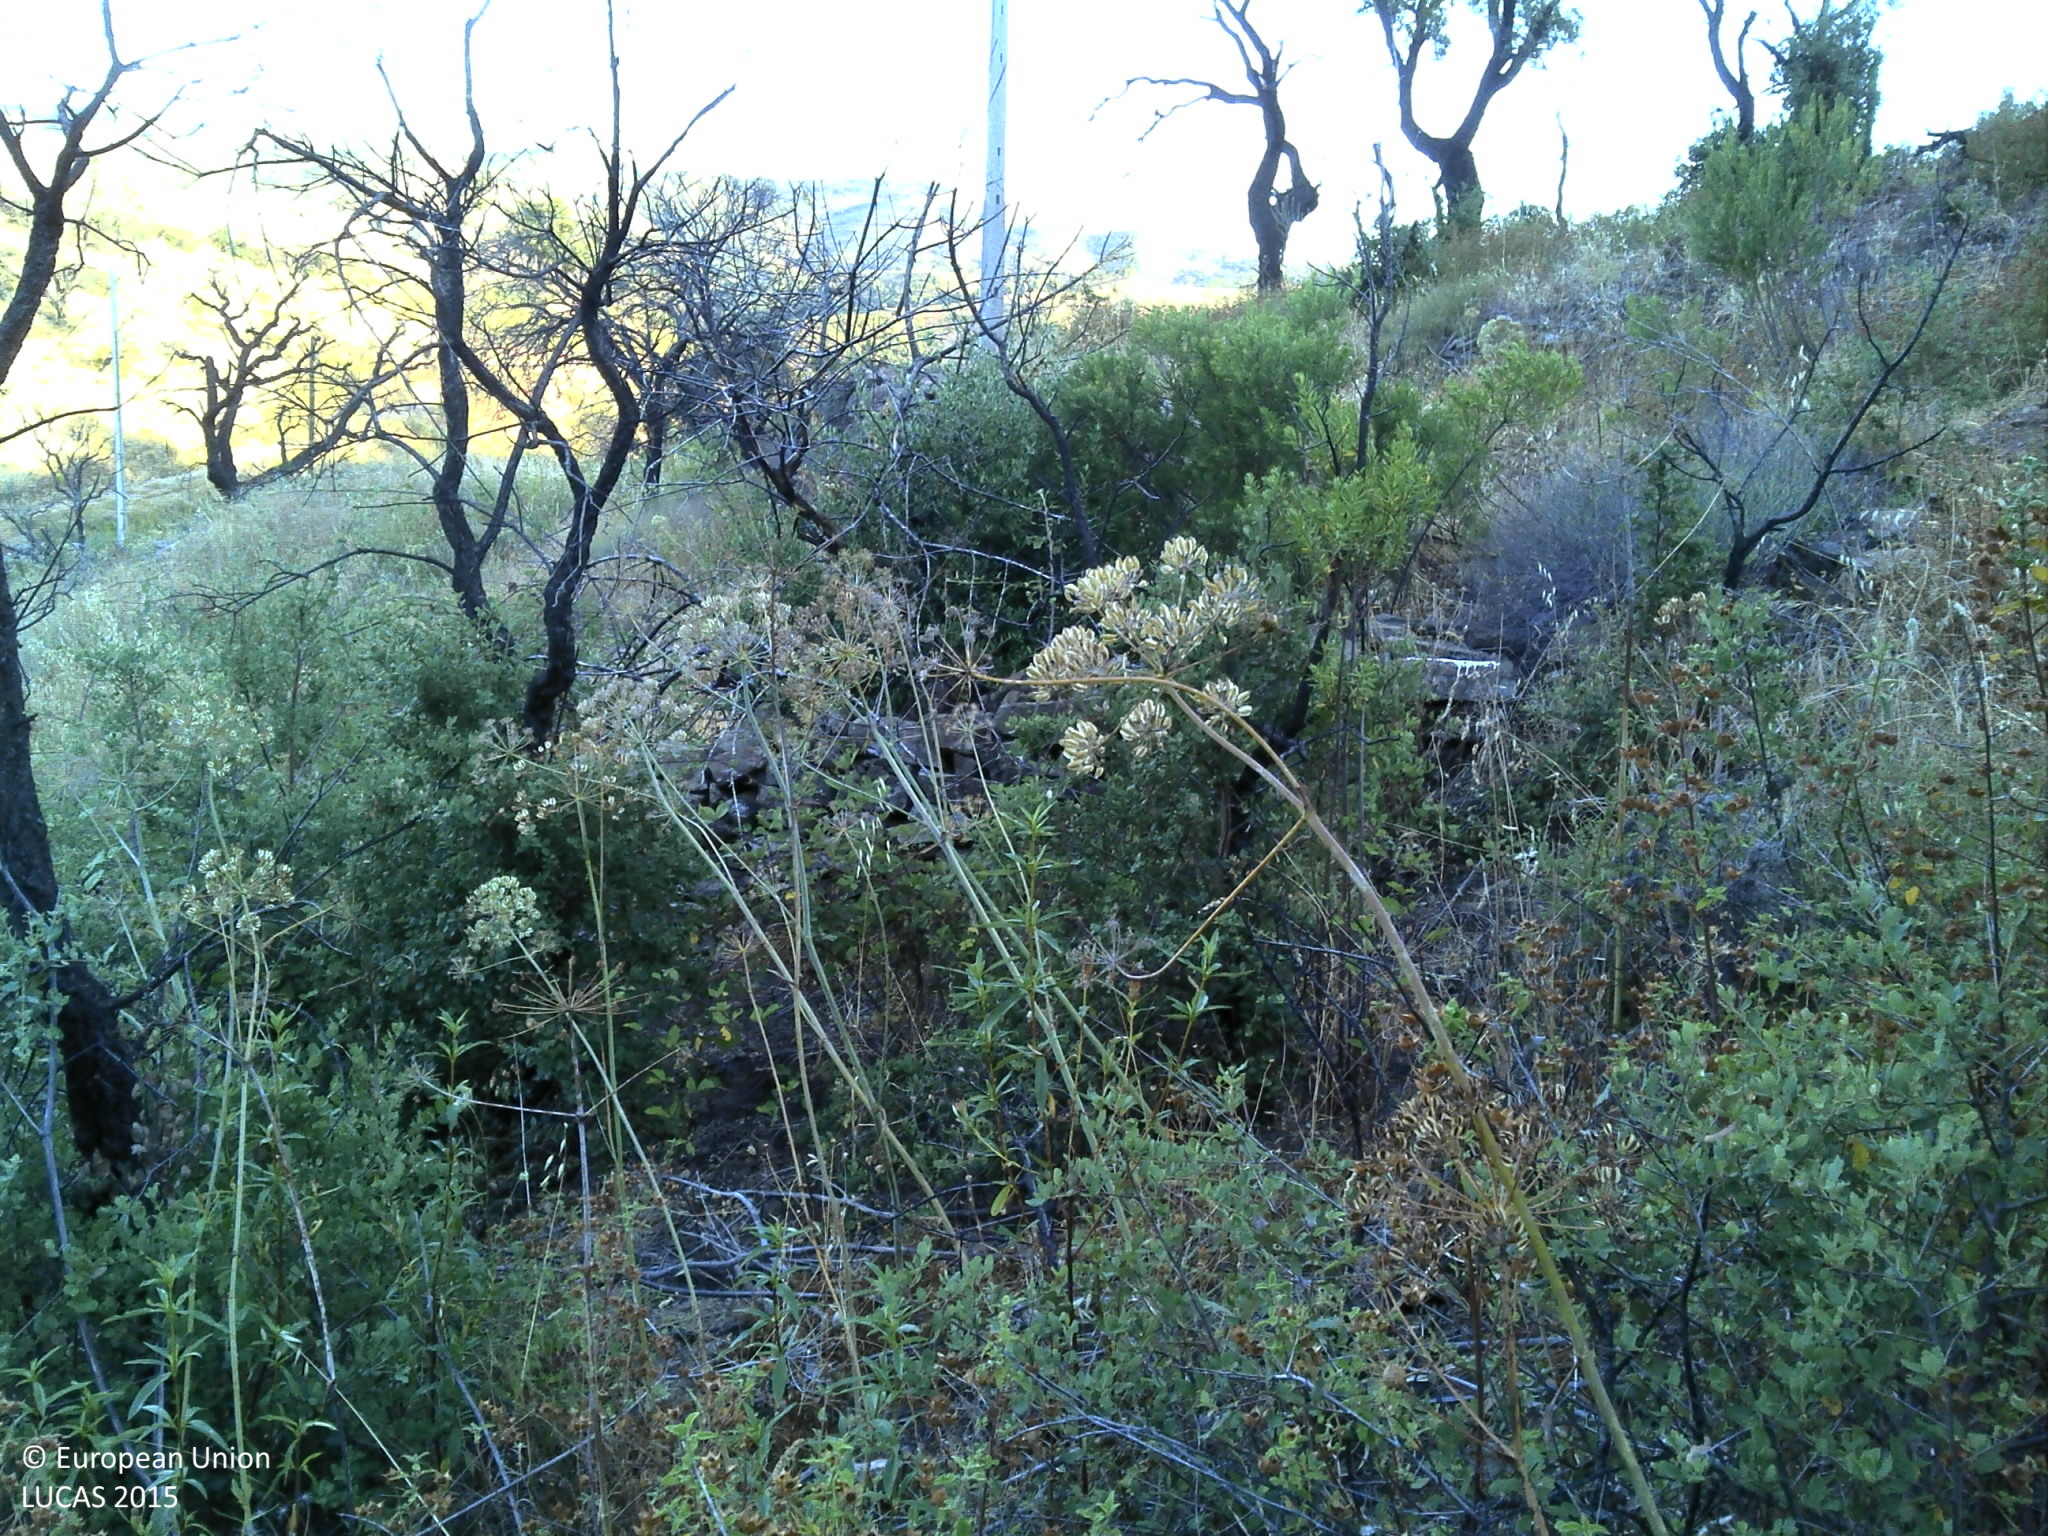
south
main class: Shrubland
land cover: Shrubland with sparse tree cover
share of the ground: > 75 %
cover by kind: shrubs 95 %, broadleaved forest trees 5 %
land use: Abandoned areas
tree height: < 5 m
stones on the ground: < 10 %
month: June
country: PT
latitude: 37.2674
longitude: -7.8402
